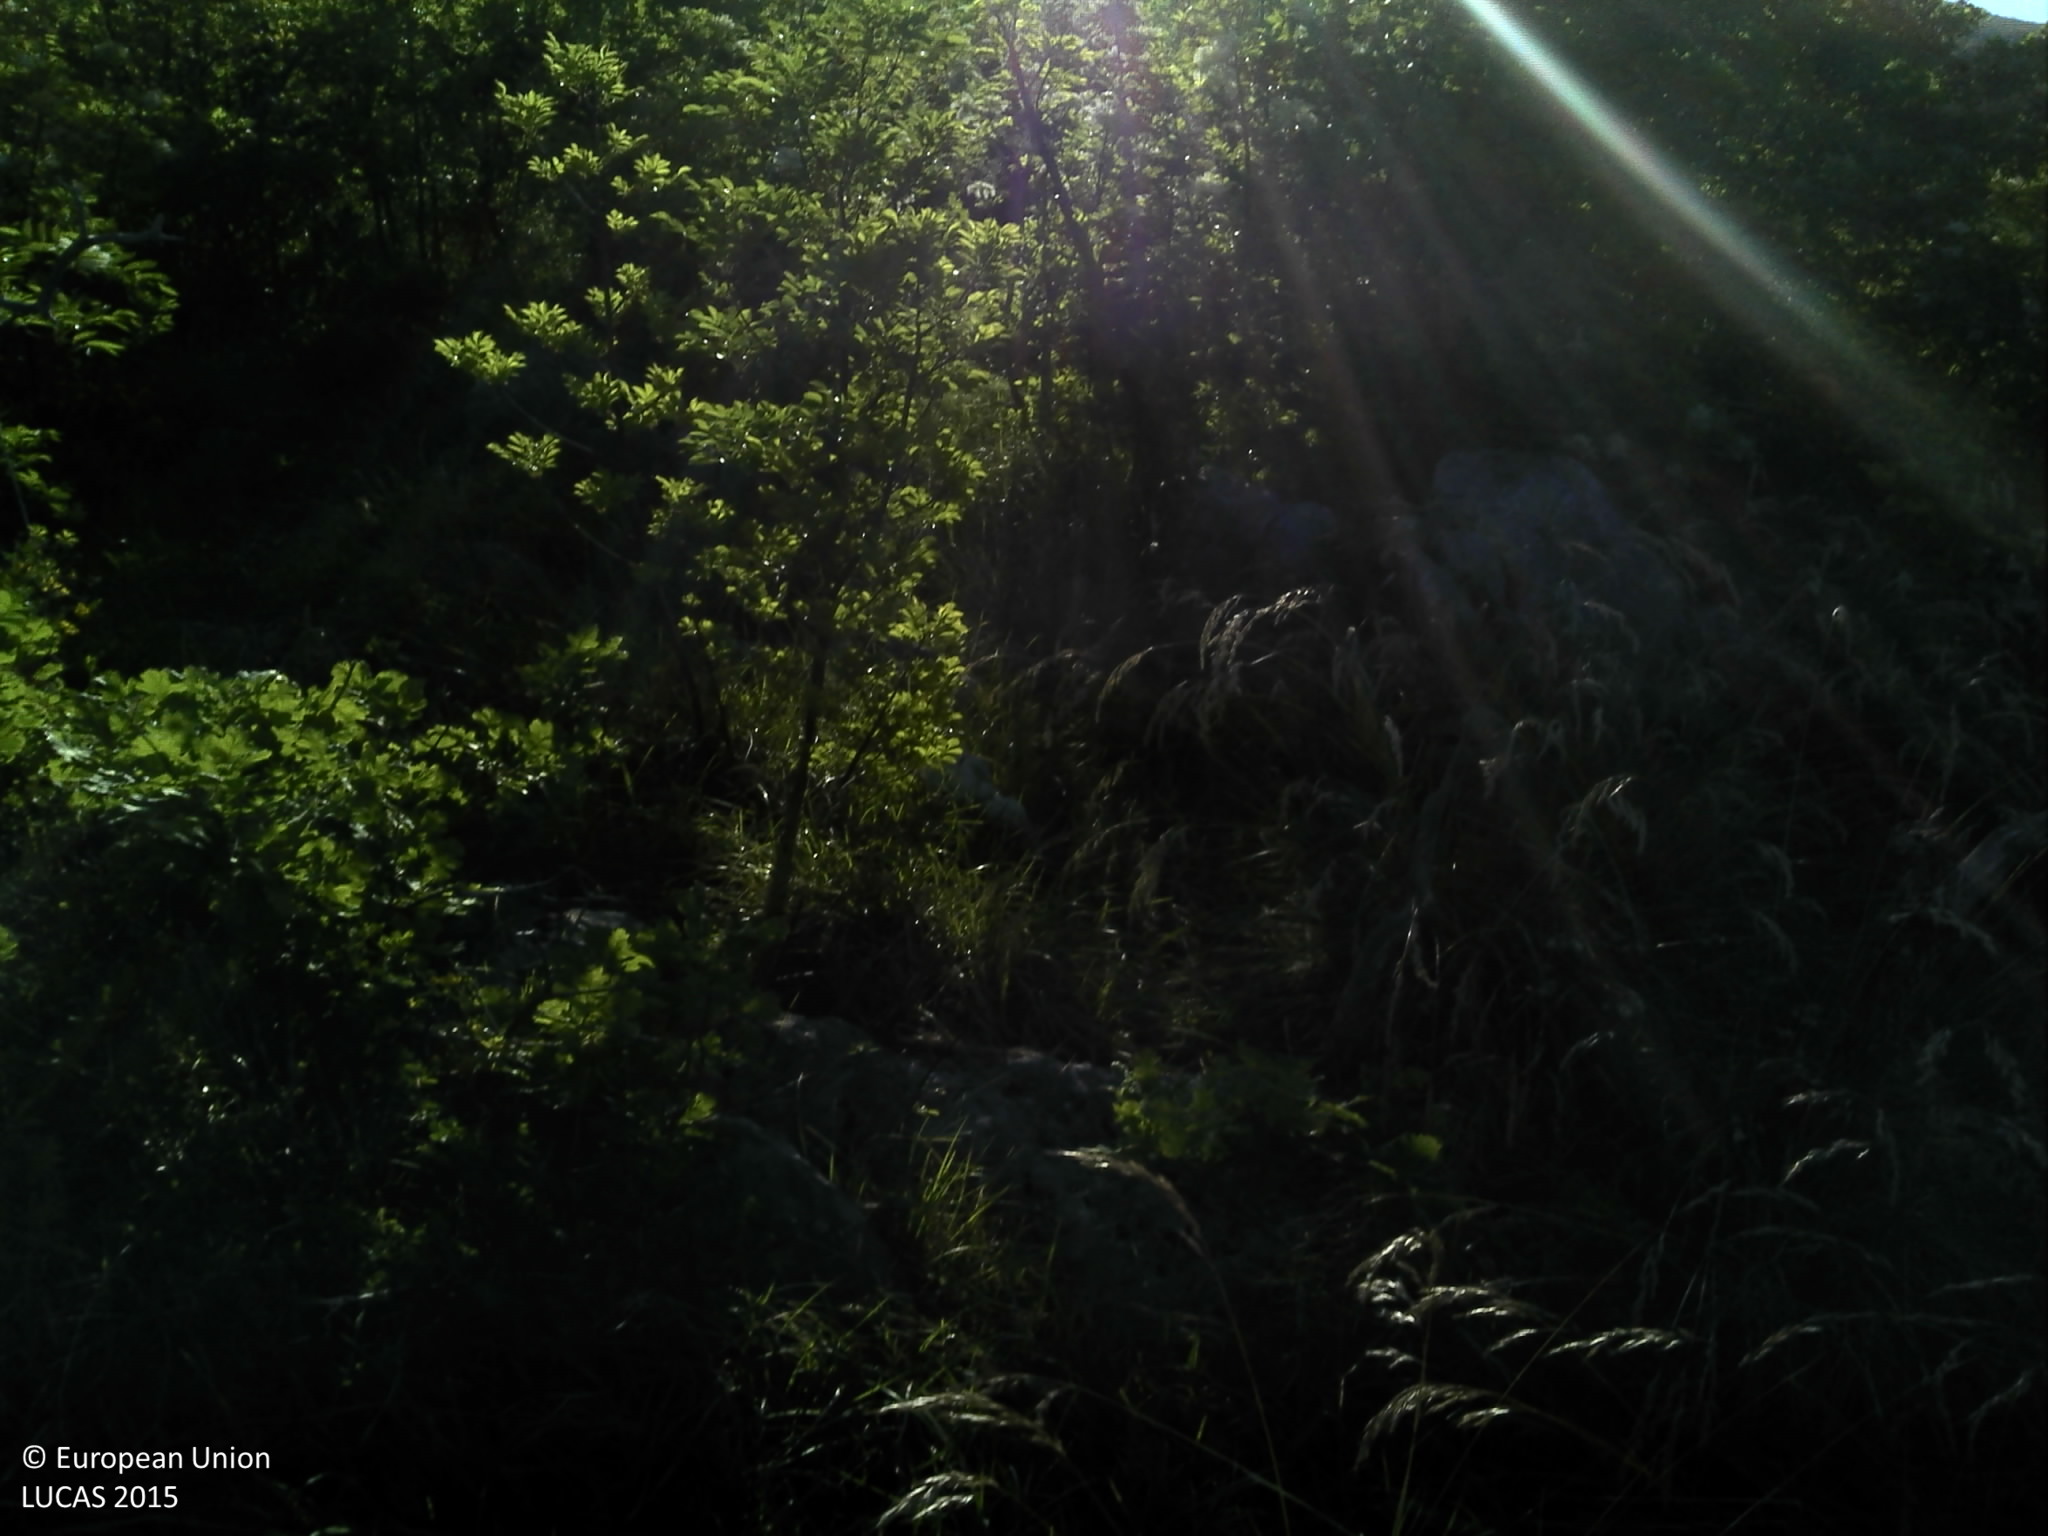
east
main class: Woodland
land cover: Broadleaved woodland
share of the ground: 10 - 25 %
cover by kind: shrubs 30 %, herbaceous plants 25 %, unconsolidated bare surface 20 %, broadleaved forest trees 15 %, lichens and mosses 5 %, consolidated bare surface 5 %
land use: Semi-natural and natural areas not in use
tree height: > 5 m
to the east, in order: Broadleaved woodland; Shrubland with sparse tree cover; Dry stone walls; Shrubland with sparse tree cover; Dry stone walls; Broadleaved woodland
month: May
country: HR
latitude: 44.0703
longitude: 16.2730
